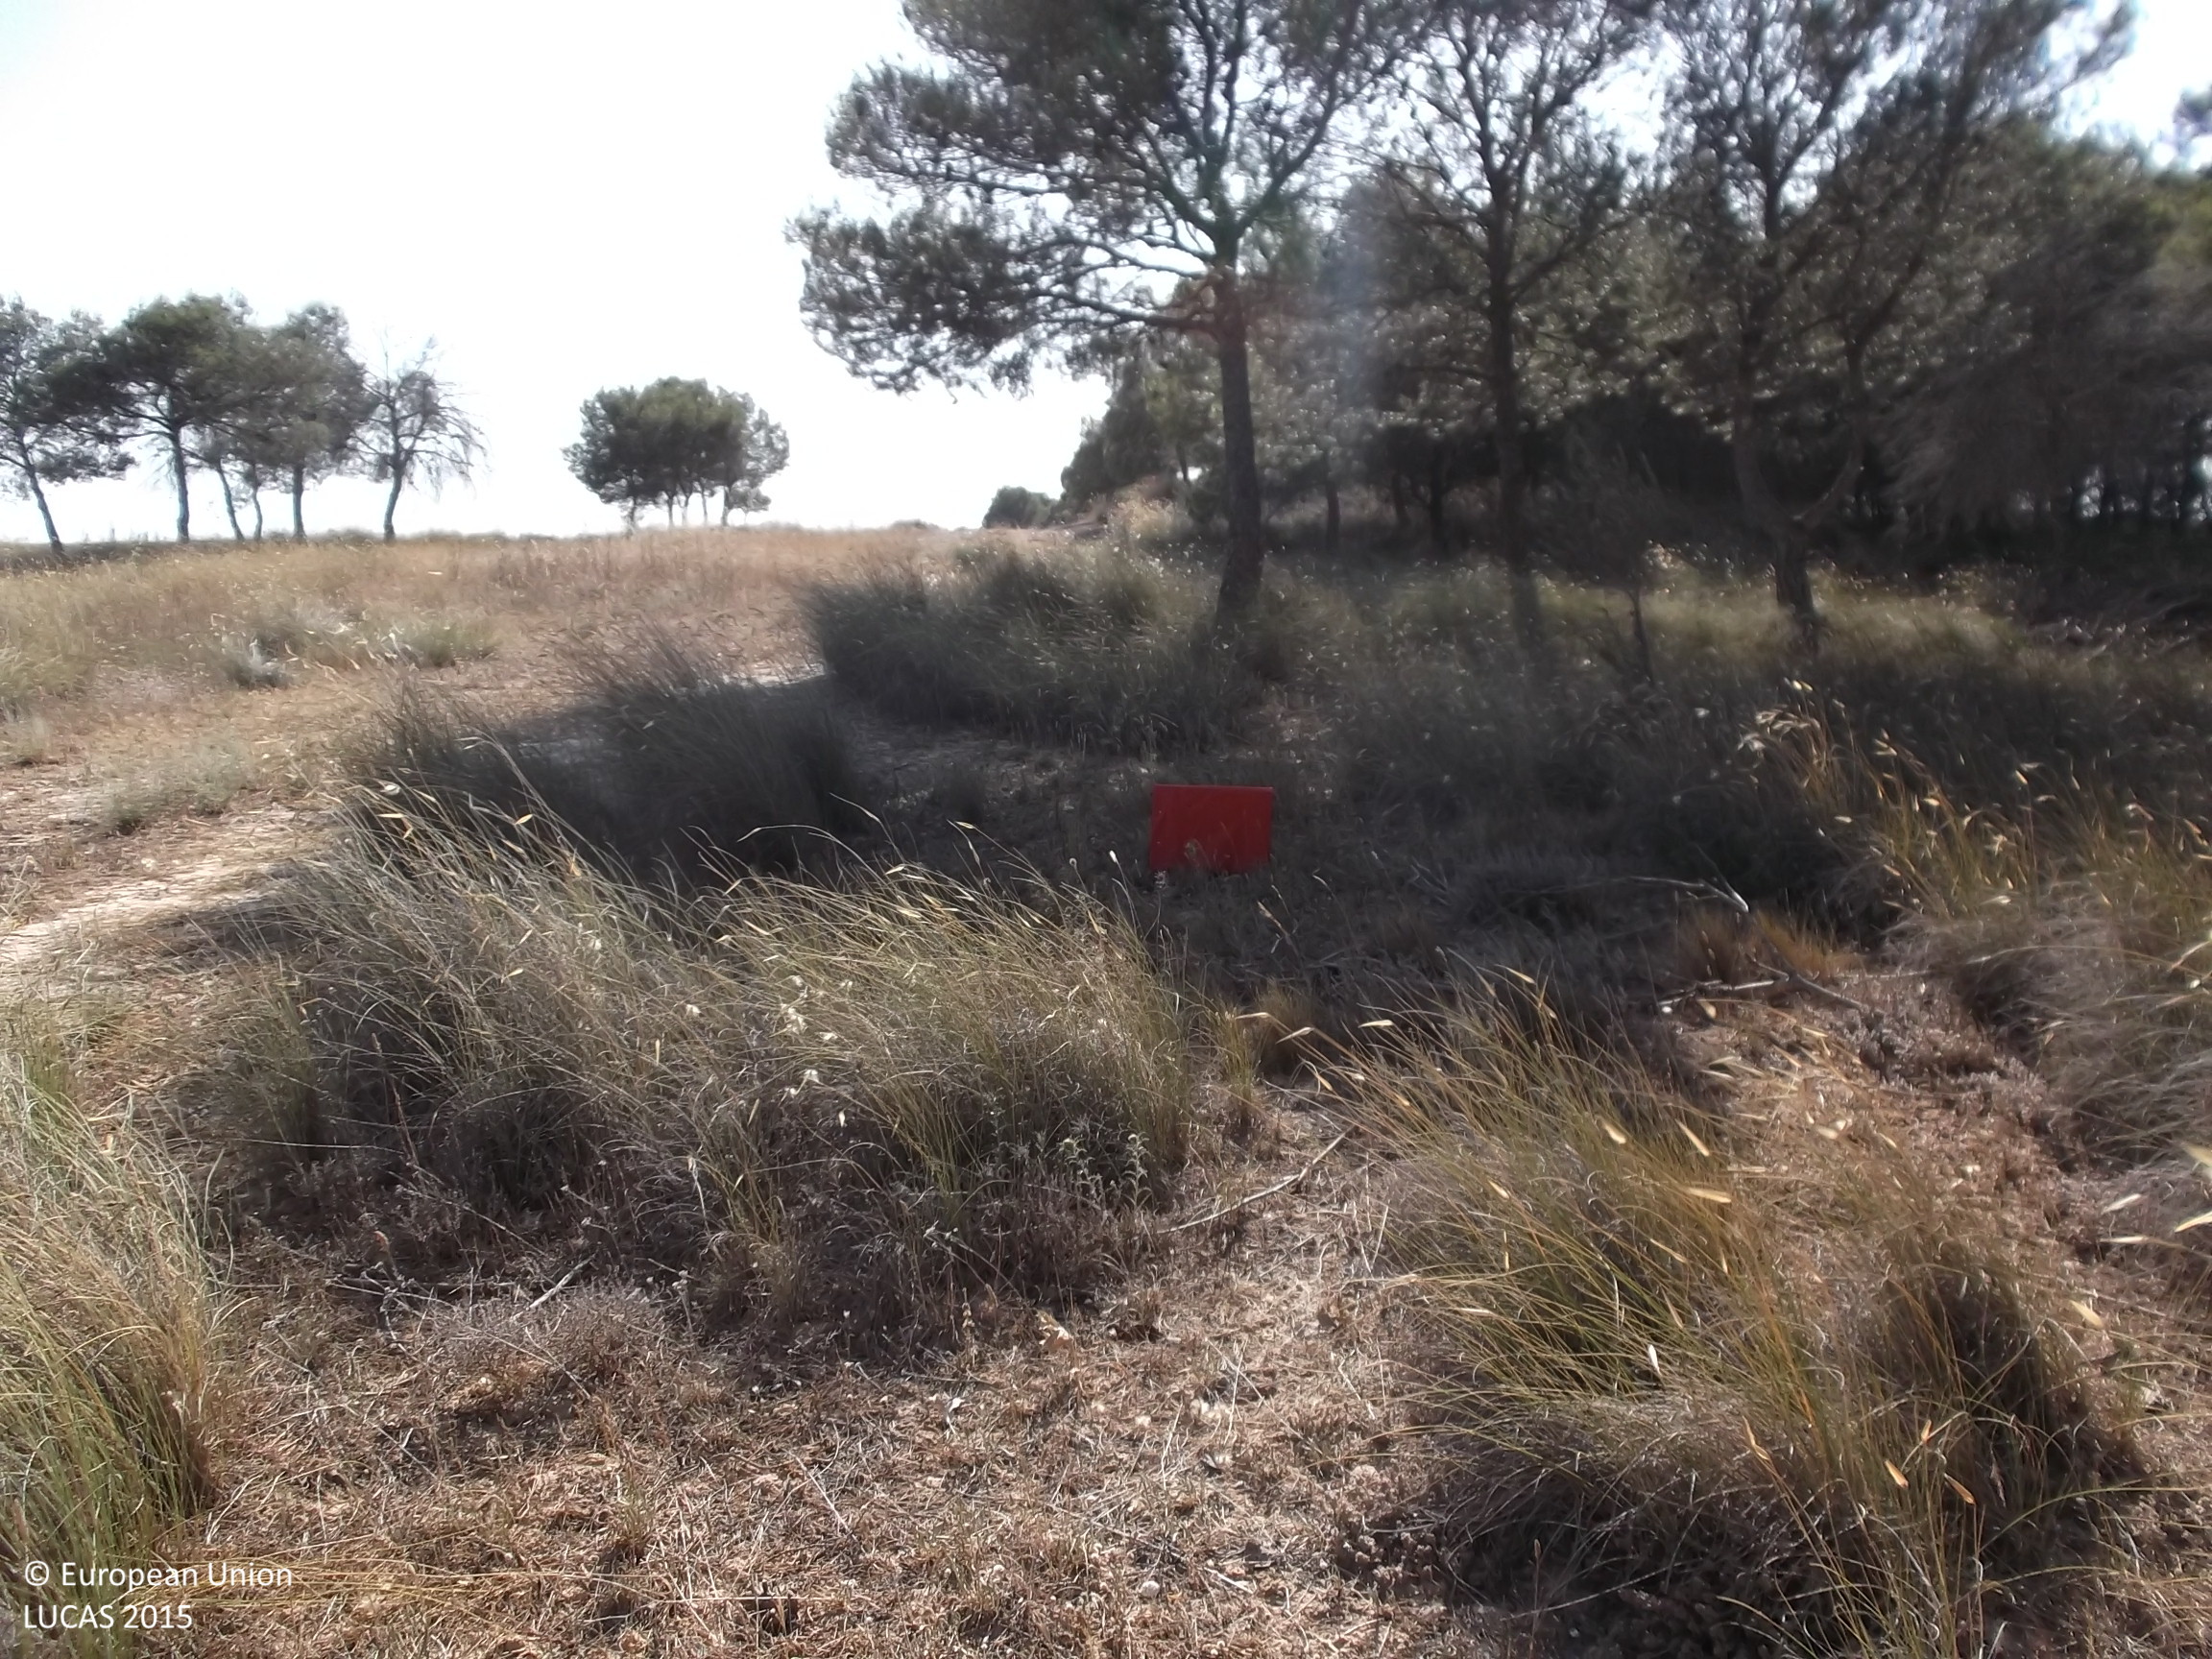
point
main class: Woodland
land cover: Pine dominated coniferous woodland
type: coniferous forest of the mediterranean region
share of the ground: 50 - 75 %
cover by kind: coniferous forest trees 70 %, herbaceous plants 20 %, unconsolidated bare surface 10 %
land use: Semi-natural and natural areas not in use
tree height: < 5 m
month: July
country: ES
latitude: 42.3315
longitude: -1.5999
